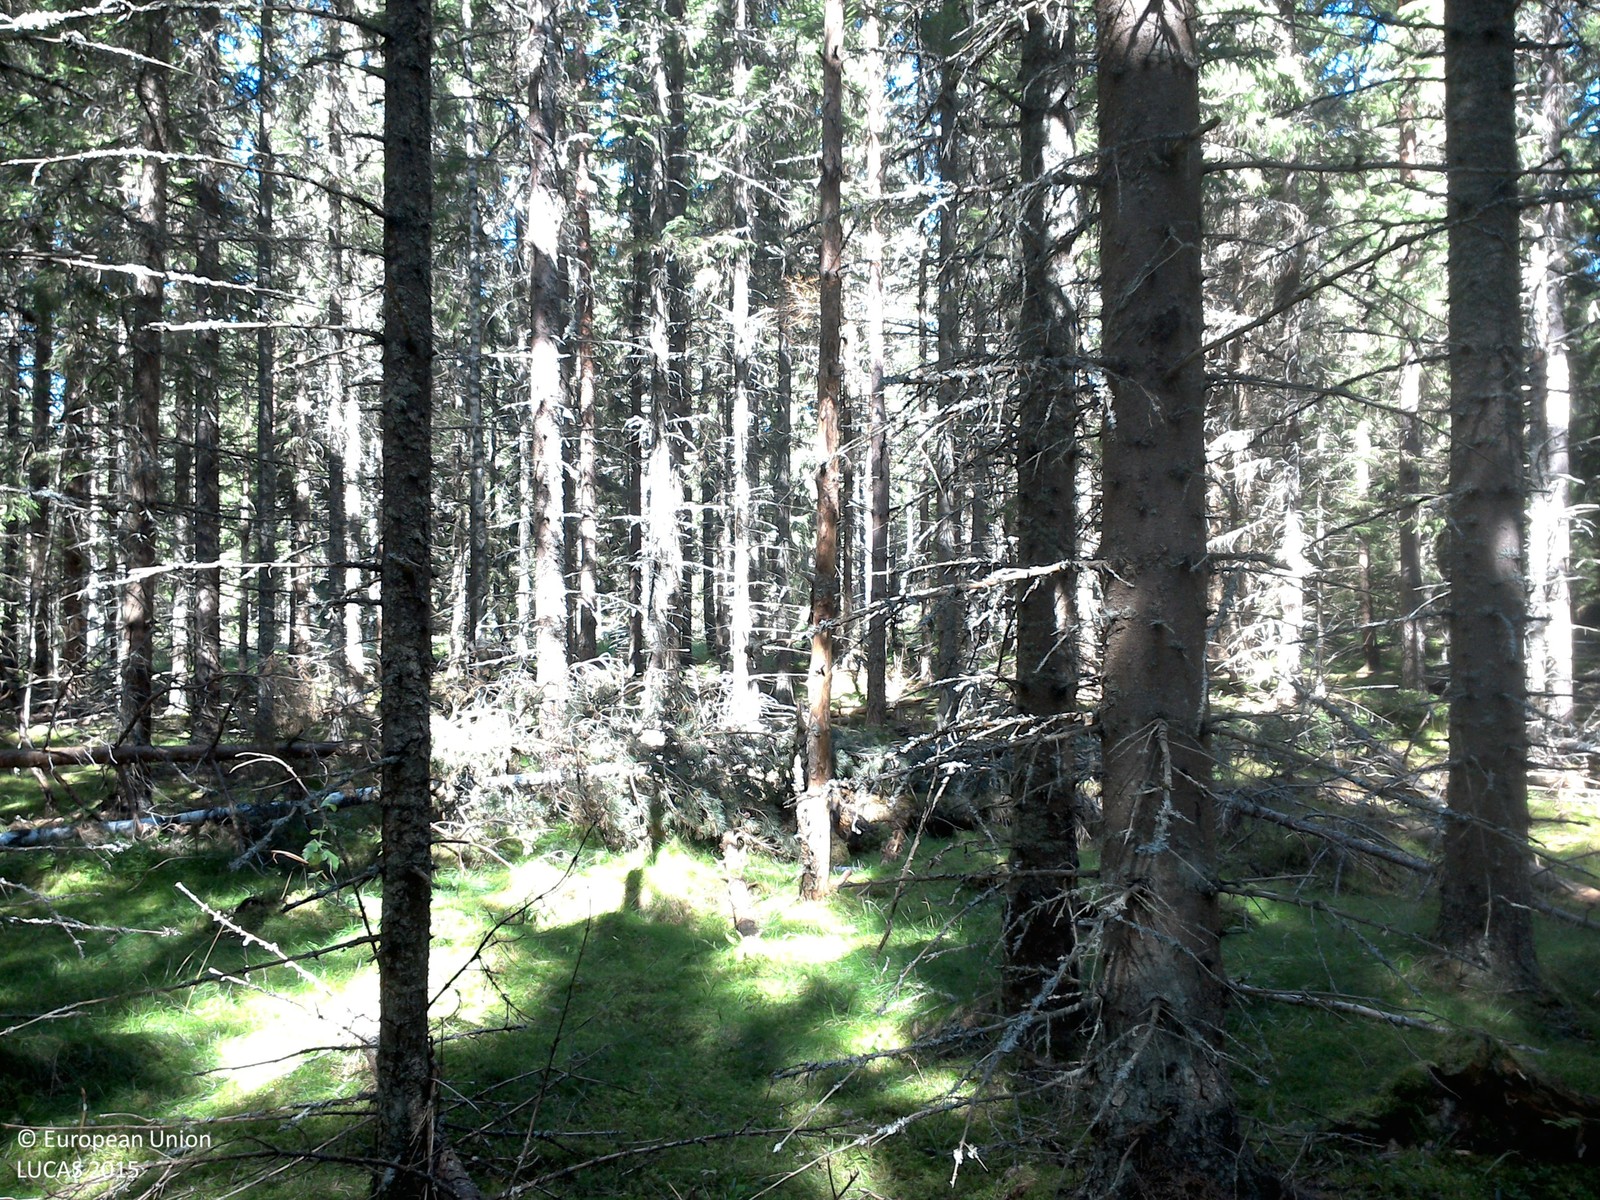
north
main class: Woodland
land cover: Spruce dominated coniferous woodland
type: boreal forest
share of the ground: 50 - 75 %
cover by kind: coniferous forest trees 70 %, lichens and mosses 30 %
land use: Forestry
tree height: > 5 m
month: August
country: SE
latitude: 57.9467
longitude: 15.4524
